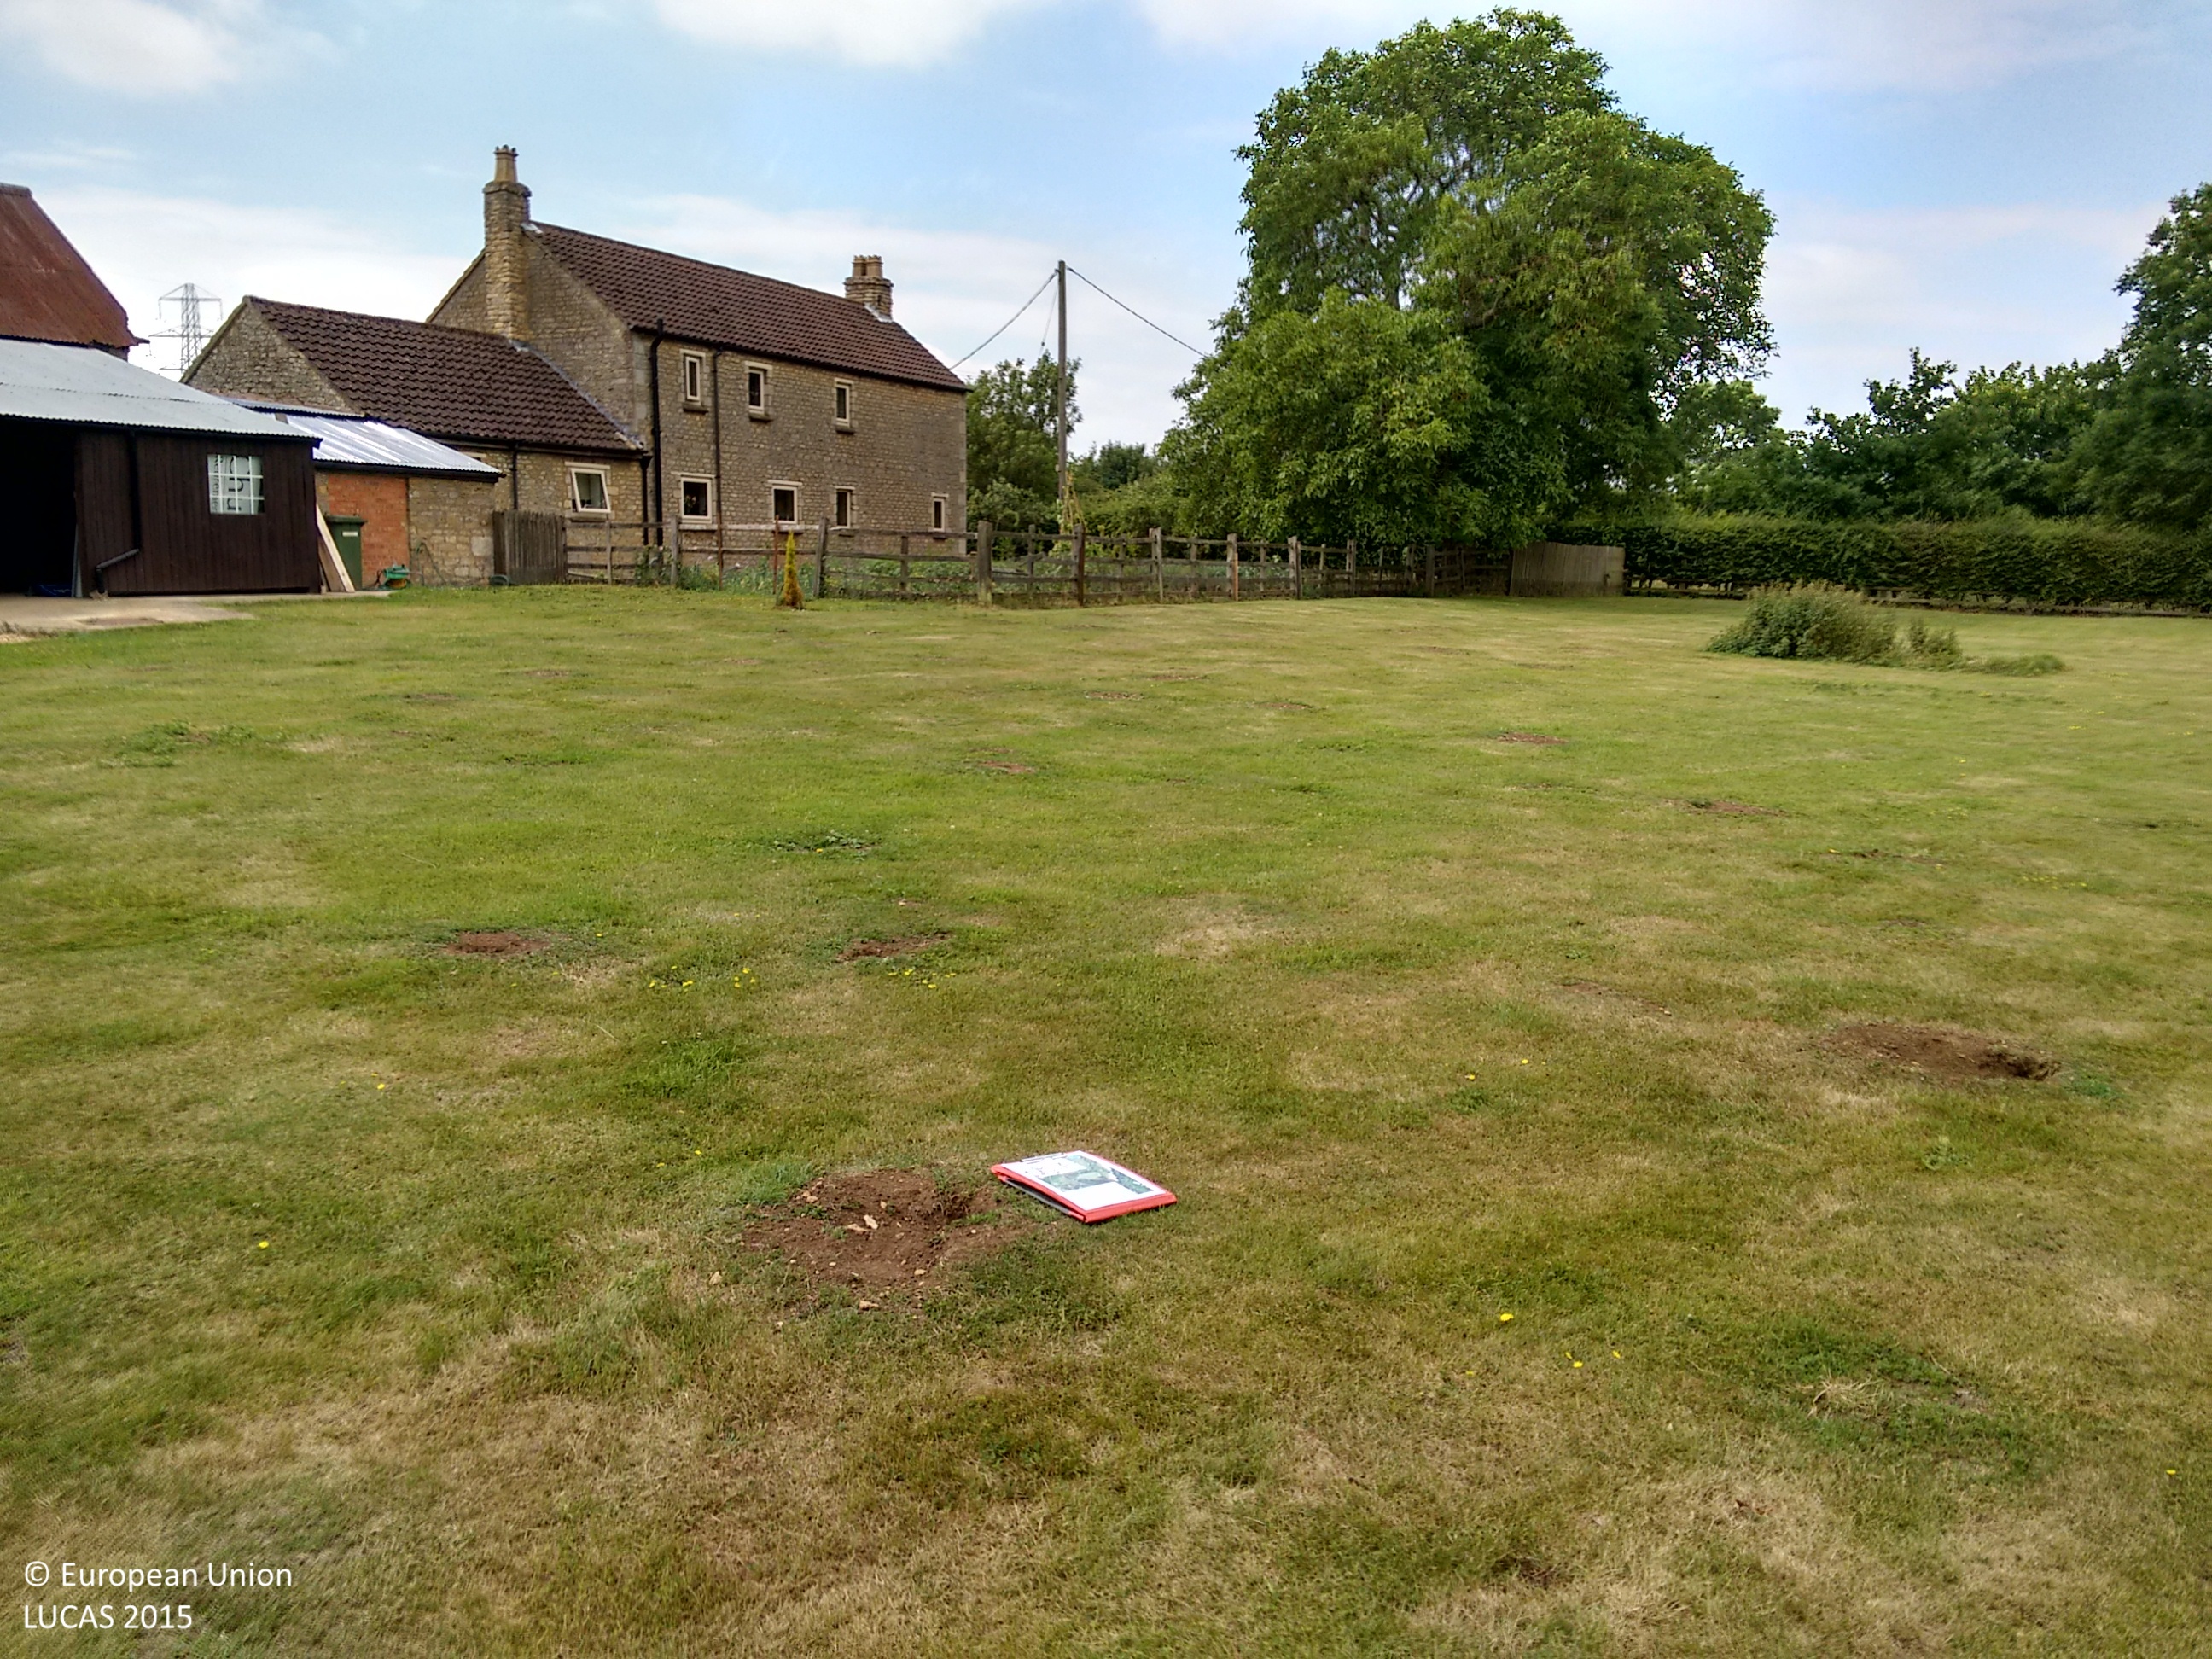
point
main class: Grassland
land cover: Grassland without tree/shrub cover
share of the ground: > 75 %
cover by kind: herbaceous plants 100 %
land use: Residential
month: July
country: GB
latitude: 52.4335
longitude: -0.7340
